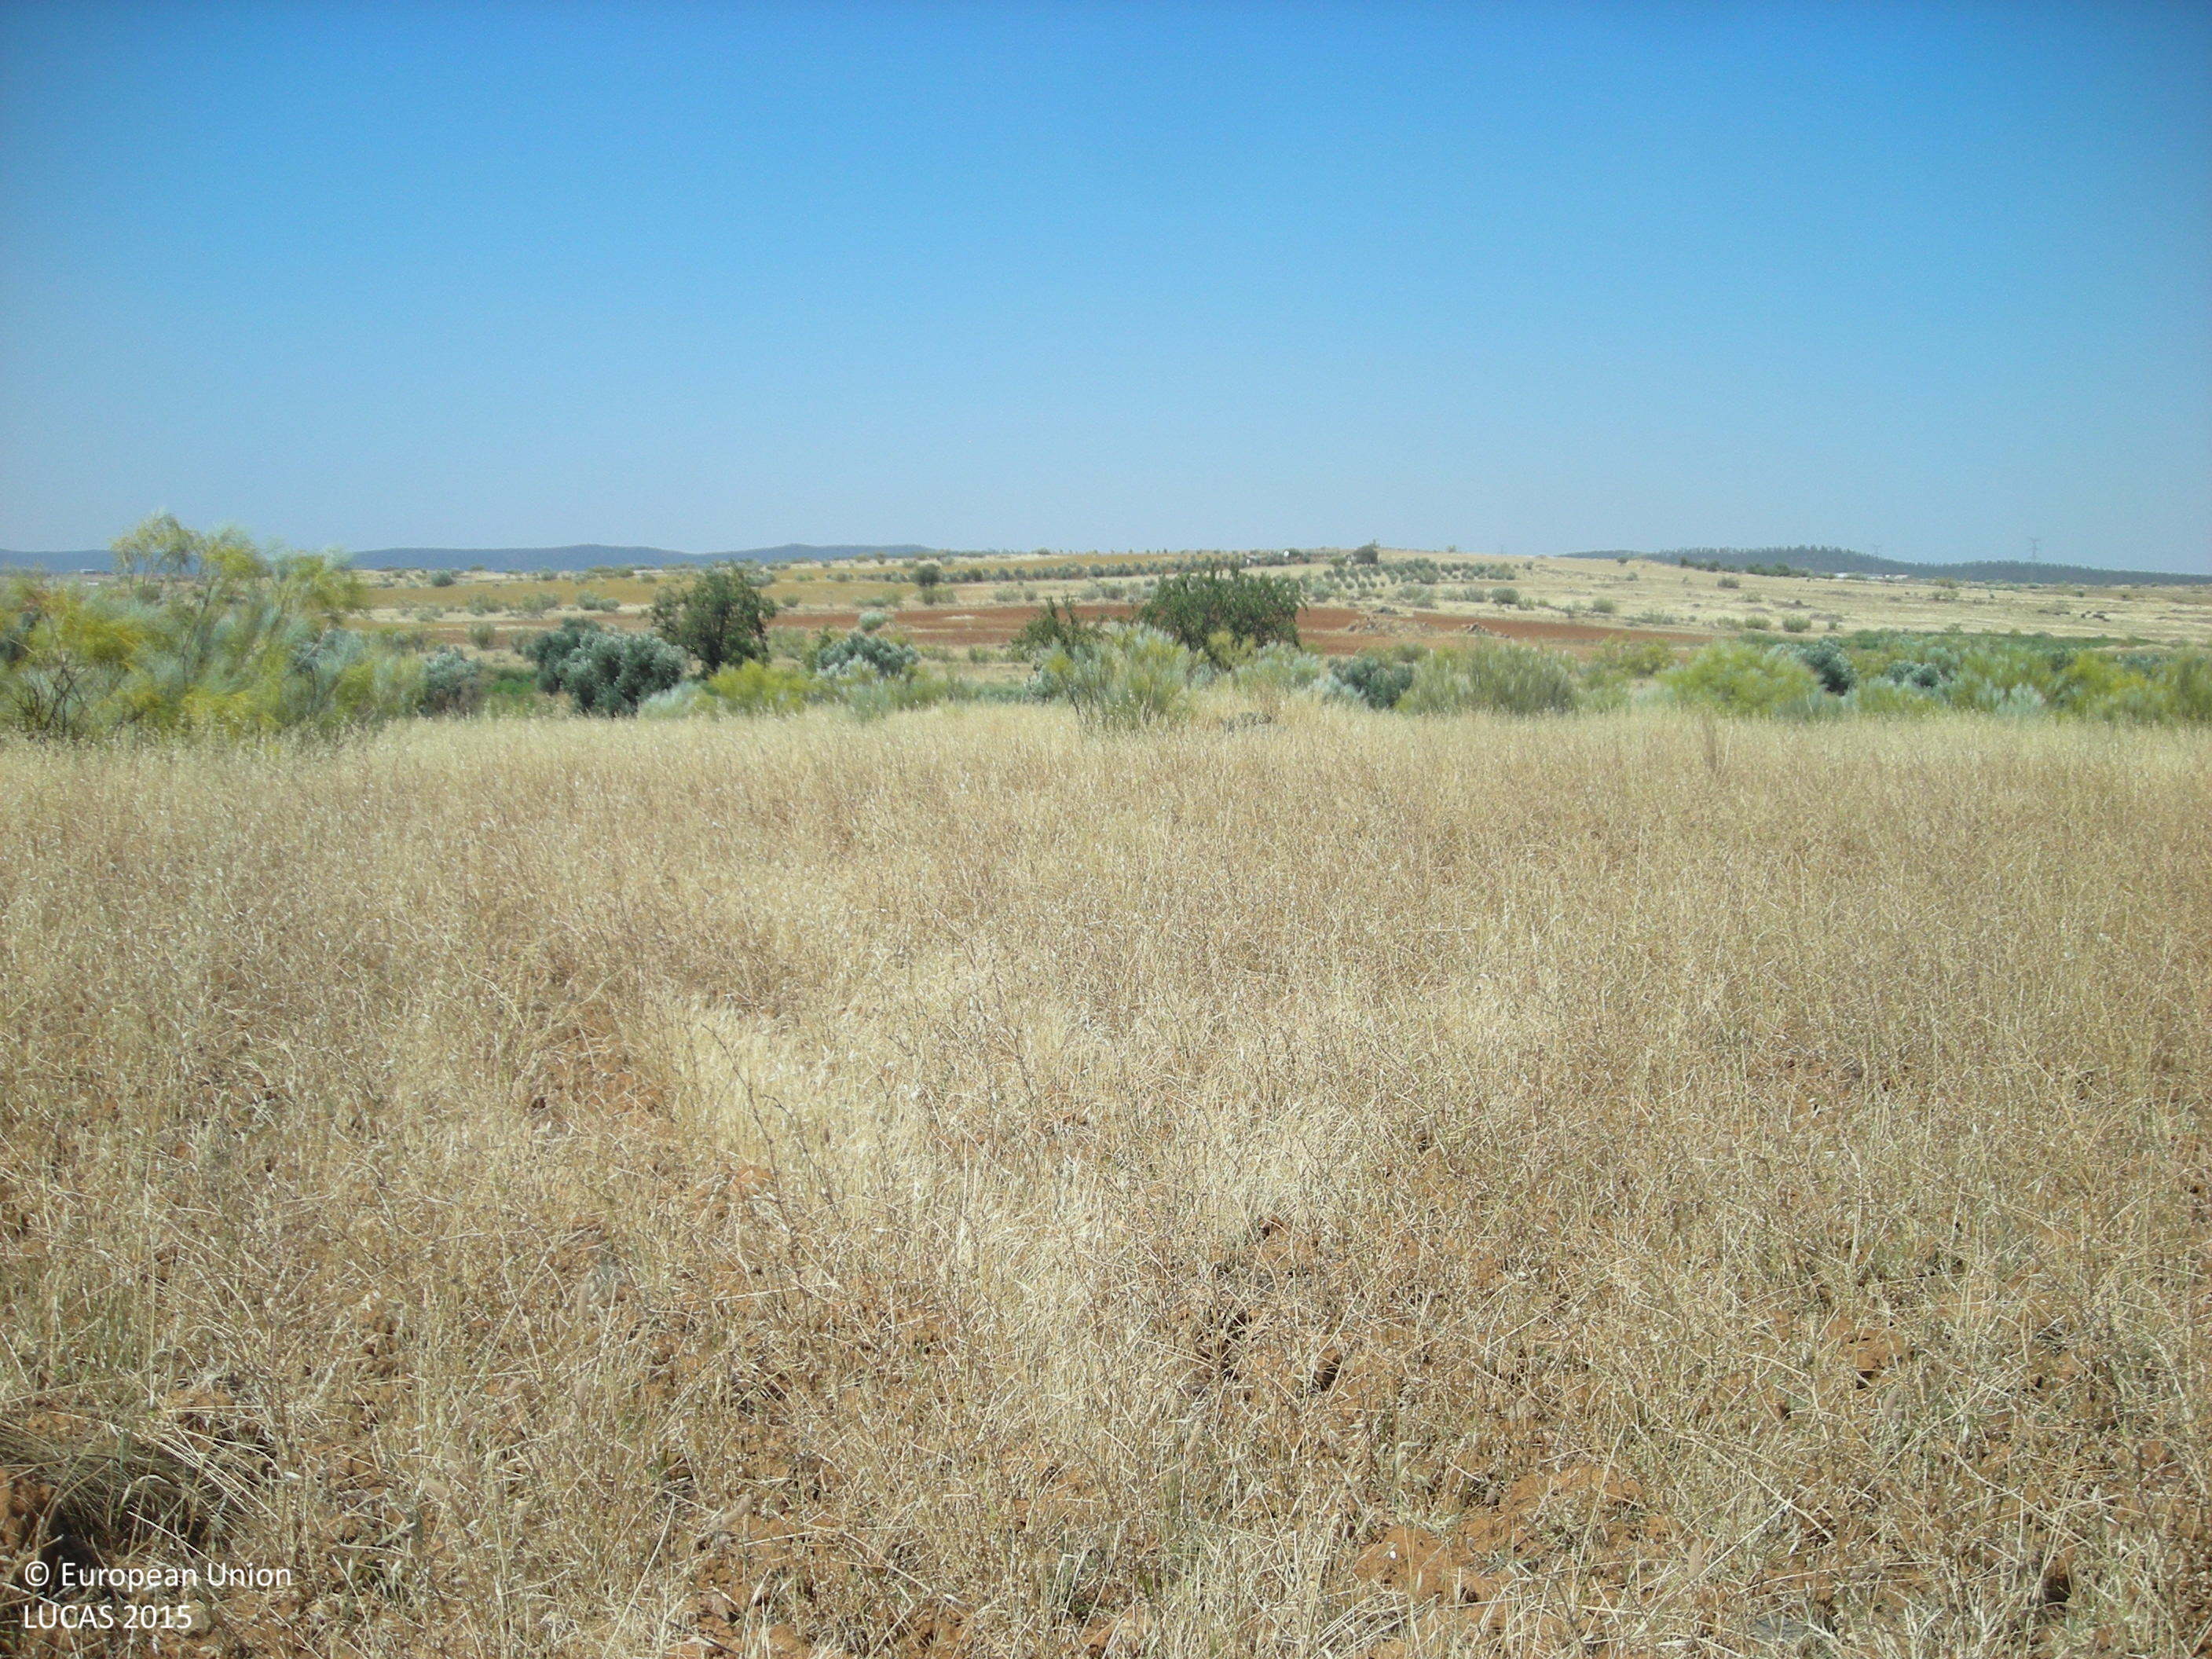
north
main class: Grassland
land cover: Grassland without tree/shrub cover
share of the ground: > 75 %
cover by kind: herbaceous plants 100 %
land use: Agriculture (excluding fallow land and kitchen gardens)
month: June
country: ES
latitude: 38.6512
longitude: -5.7730
